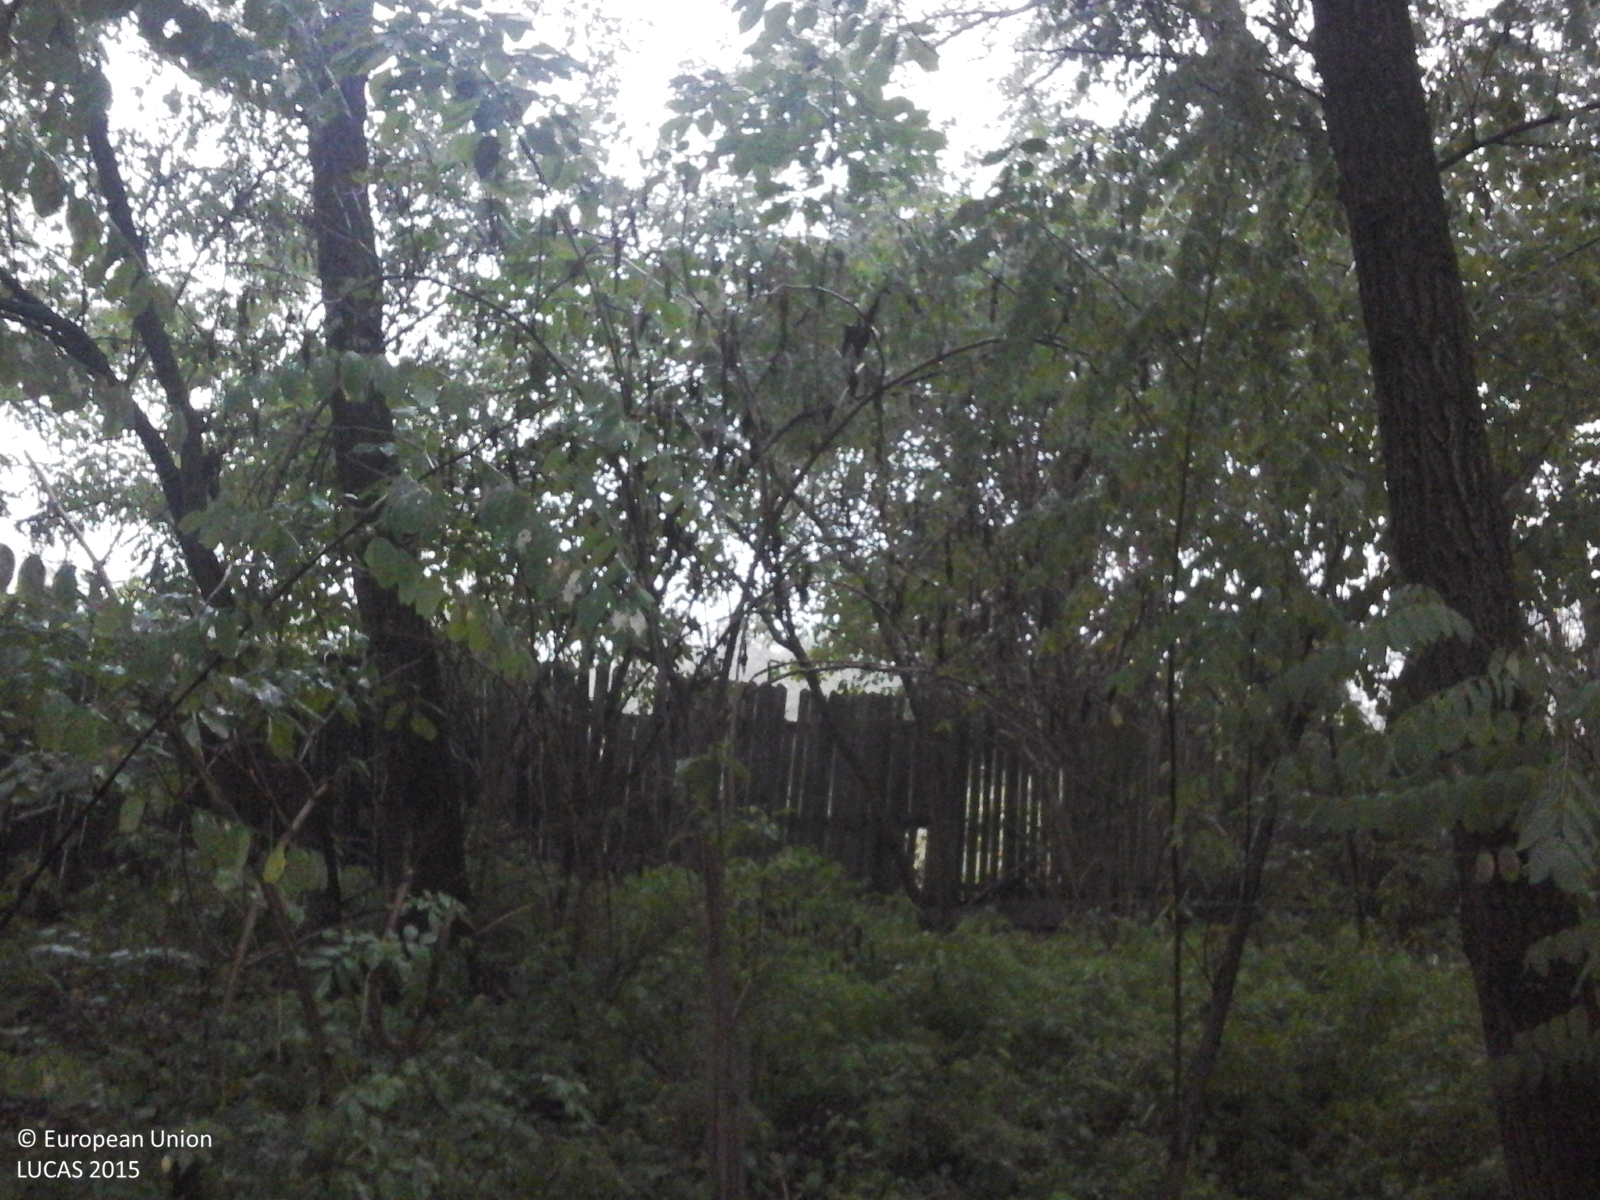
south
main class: Woodland
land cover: Broadleaved woodland
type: exotic forest
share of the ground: > 75 %
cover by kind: broadleaved forest trees 100 %
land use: Forestry
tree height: > 5 m
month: September
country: RO
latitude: 44.9271
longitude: 22.9072
